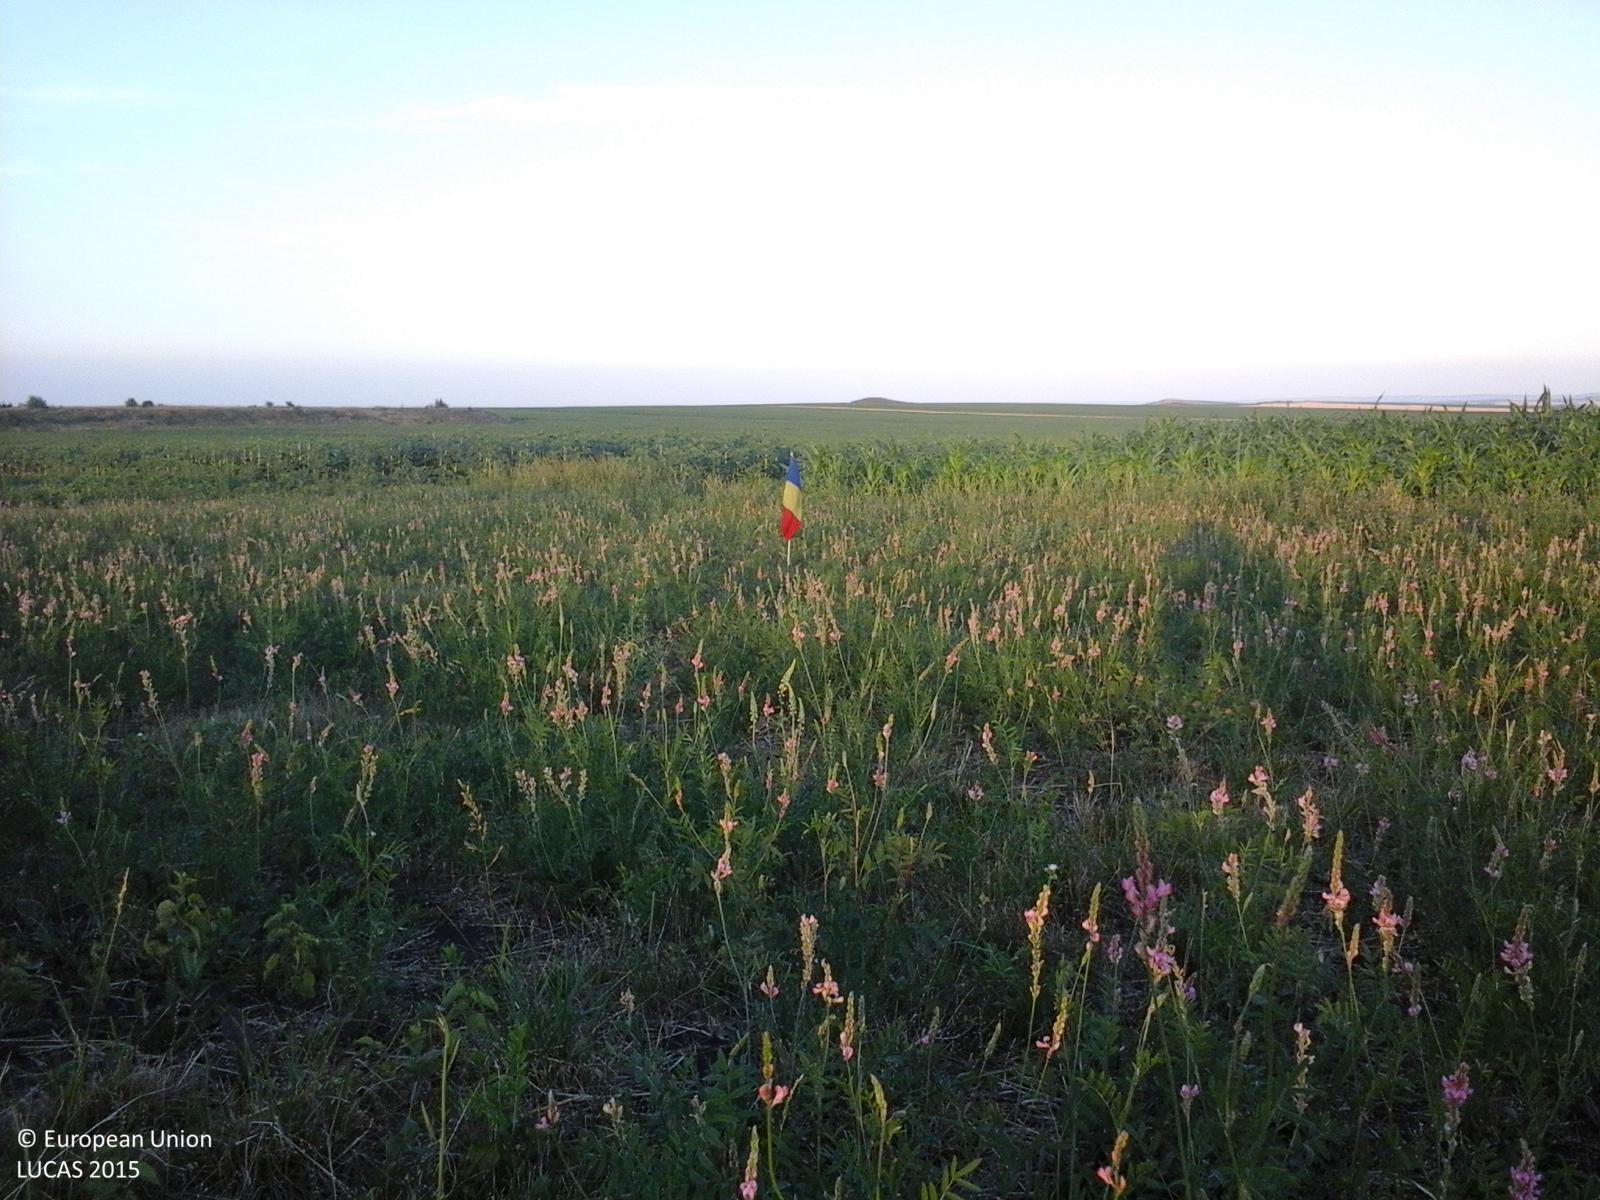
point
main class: Cropland
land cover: Other leguminous and mixtures for fodder
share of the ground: > 75 %
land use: Agriculture (excluding fallow land and kitchen gardens)
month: June
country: RO
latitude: 47.2758
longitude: 27.1181
